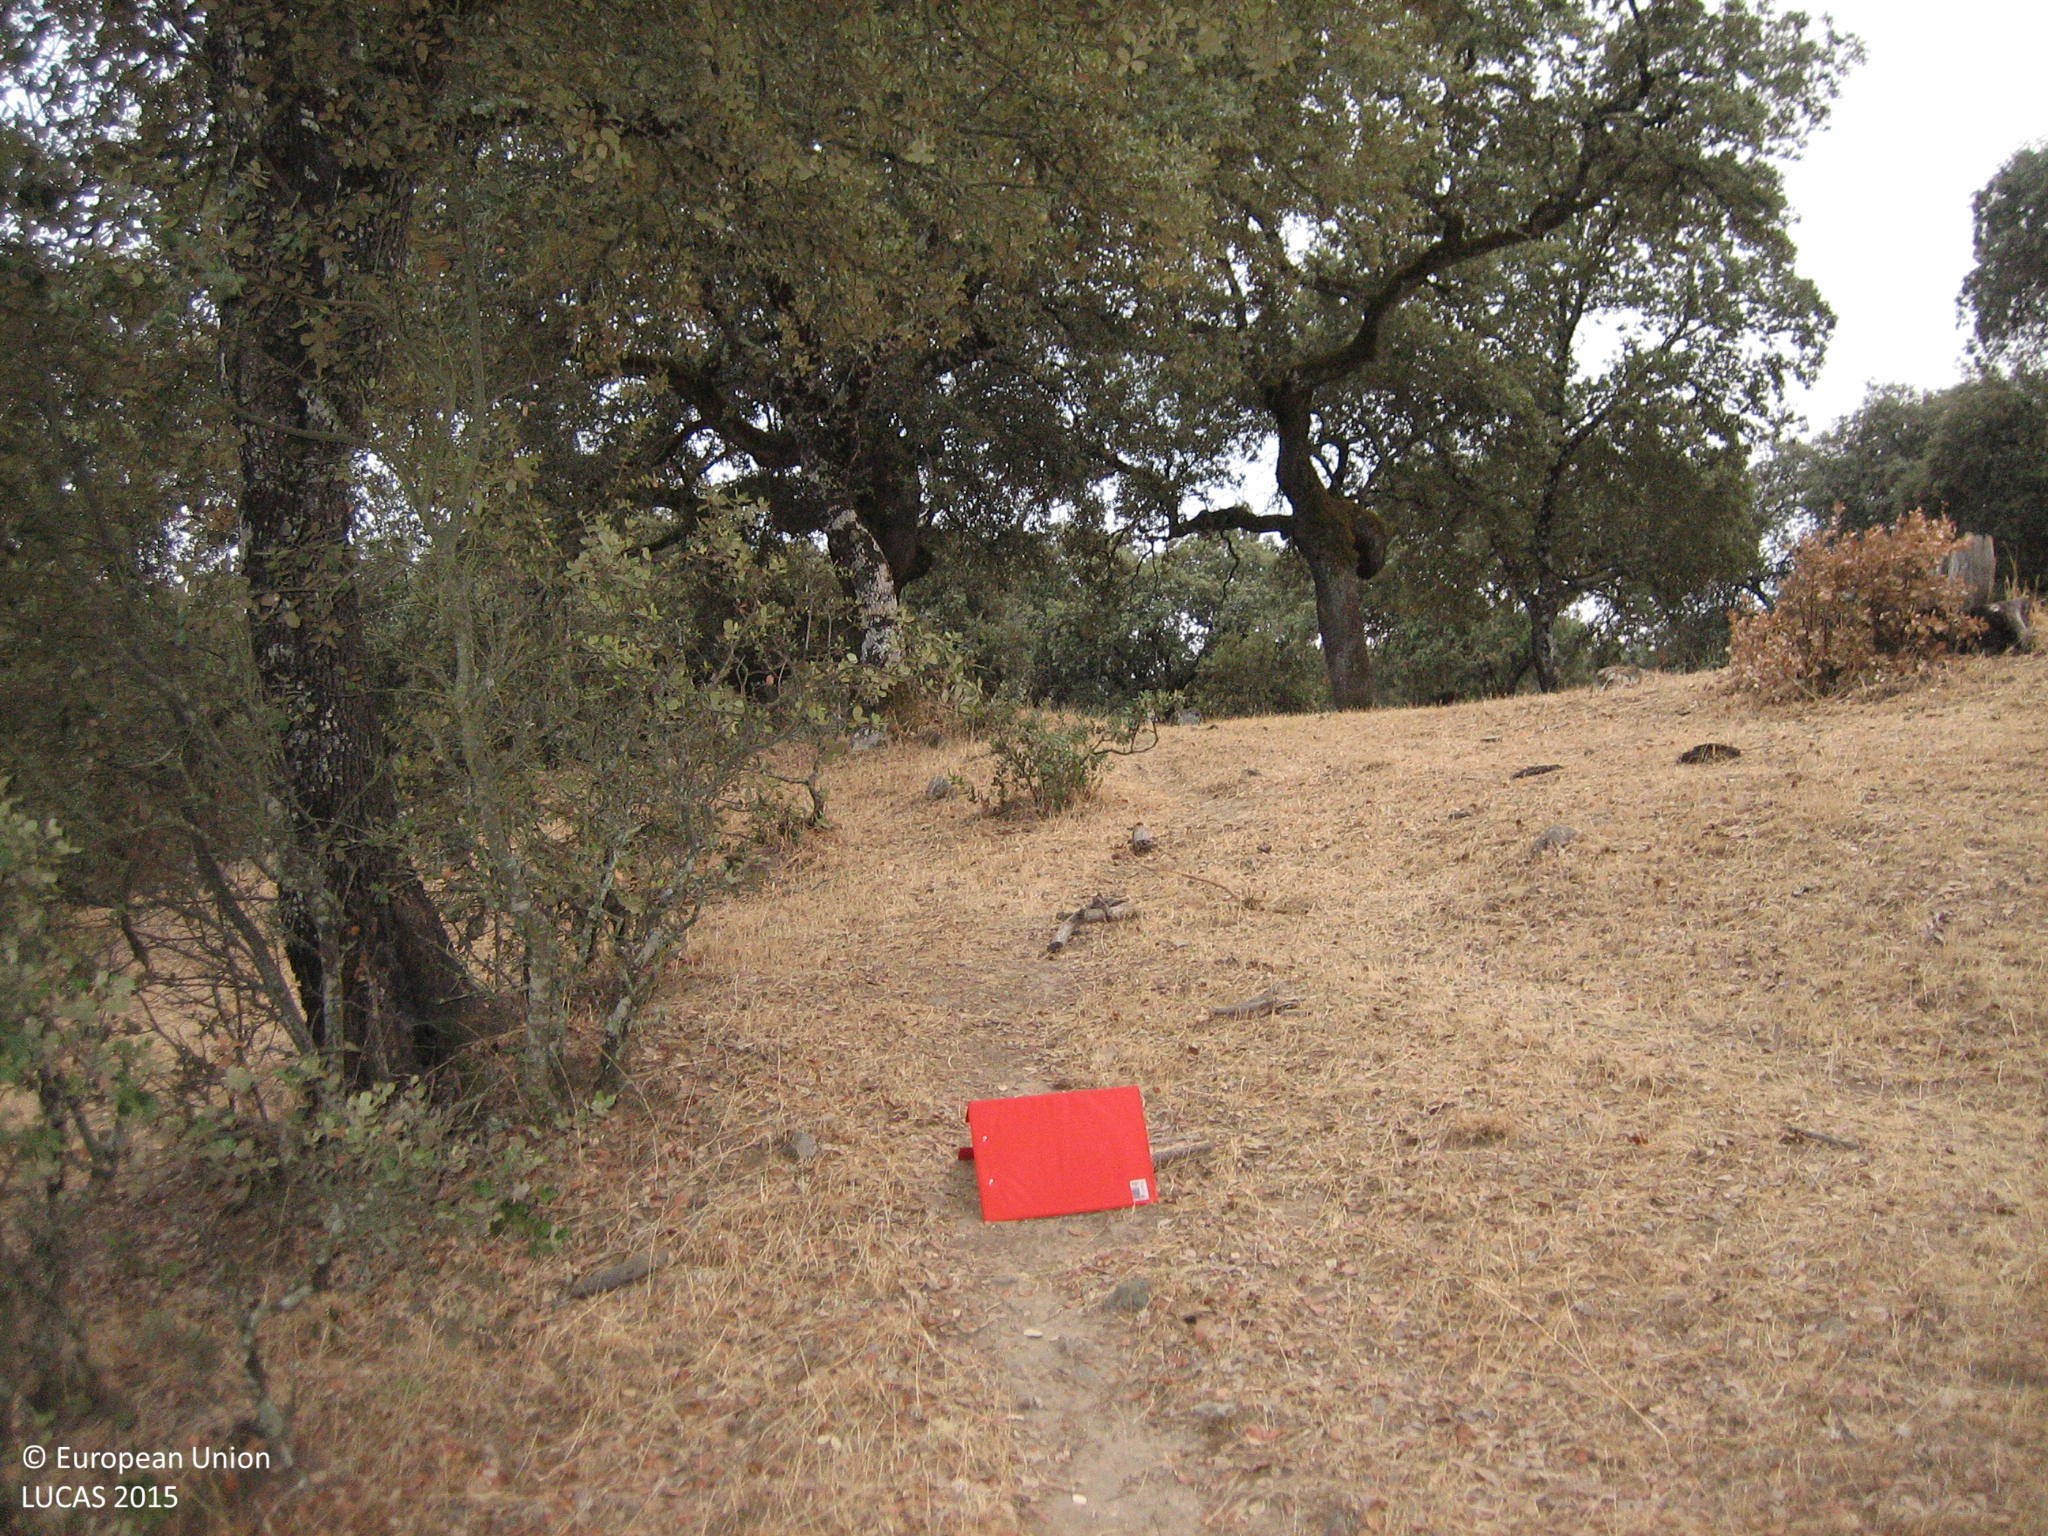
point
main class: Woodland
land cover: Broadleaved woodland
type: broadleaved evergreen forest
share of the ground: 25 - 50 %
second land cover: Grassland without tree/shrub cover
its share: > 75 %
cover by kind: herbaceous plants 55 %, broadleaved forest trees 40 %, shrubs 5 %
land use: Forestry
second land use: Agriculture (excluding fallow land and kitchen gardens)
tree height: > 5 m
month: September
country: ES
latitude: 38.3386
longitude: -6.8409
